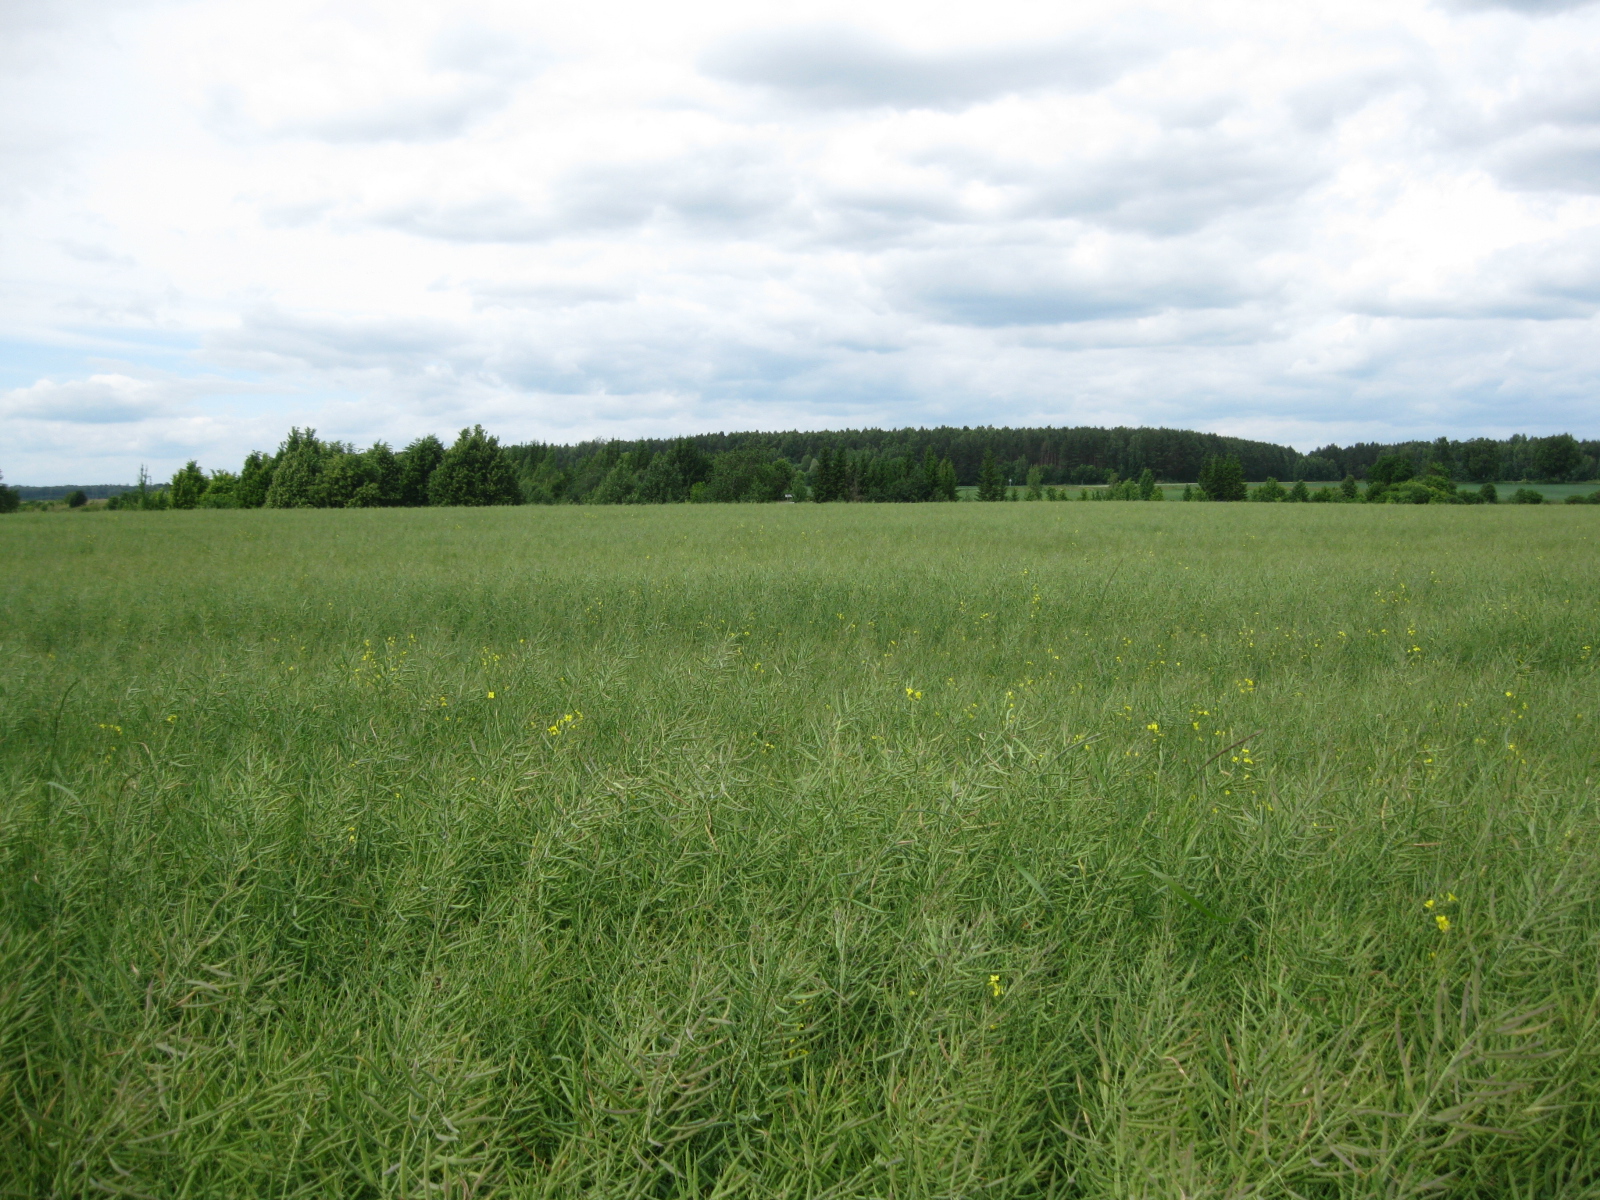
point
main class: Cropland
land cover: Rape and turnip rape
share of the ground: > 75 %
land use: Agriculture (excluding fallow land and kitchen gardens)
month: June
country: LT
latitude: 55.6076
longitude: 24.2377
